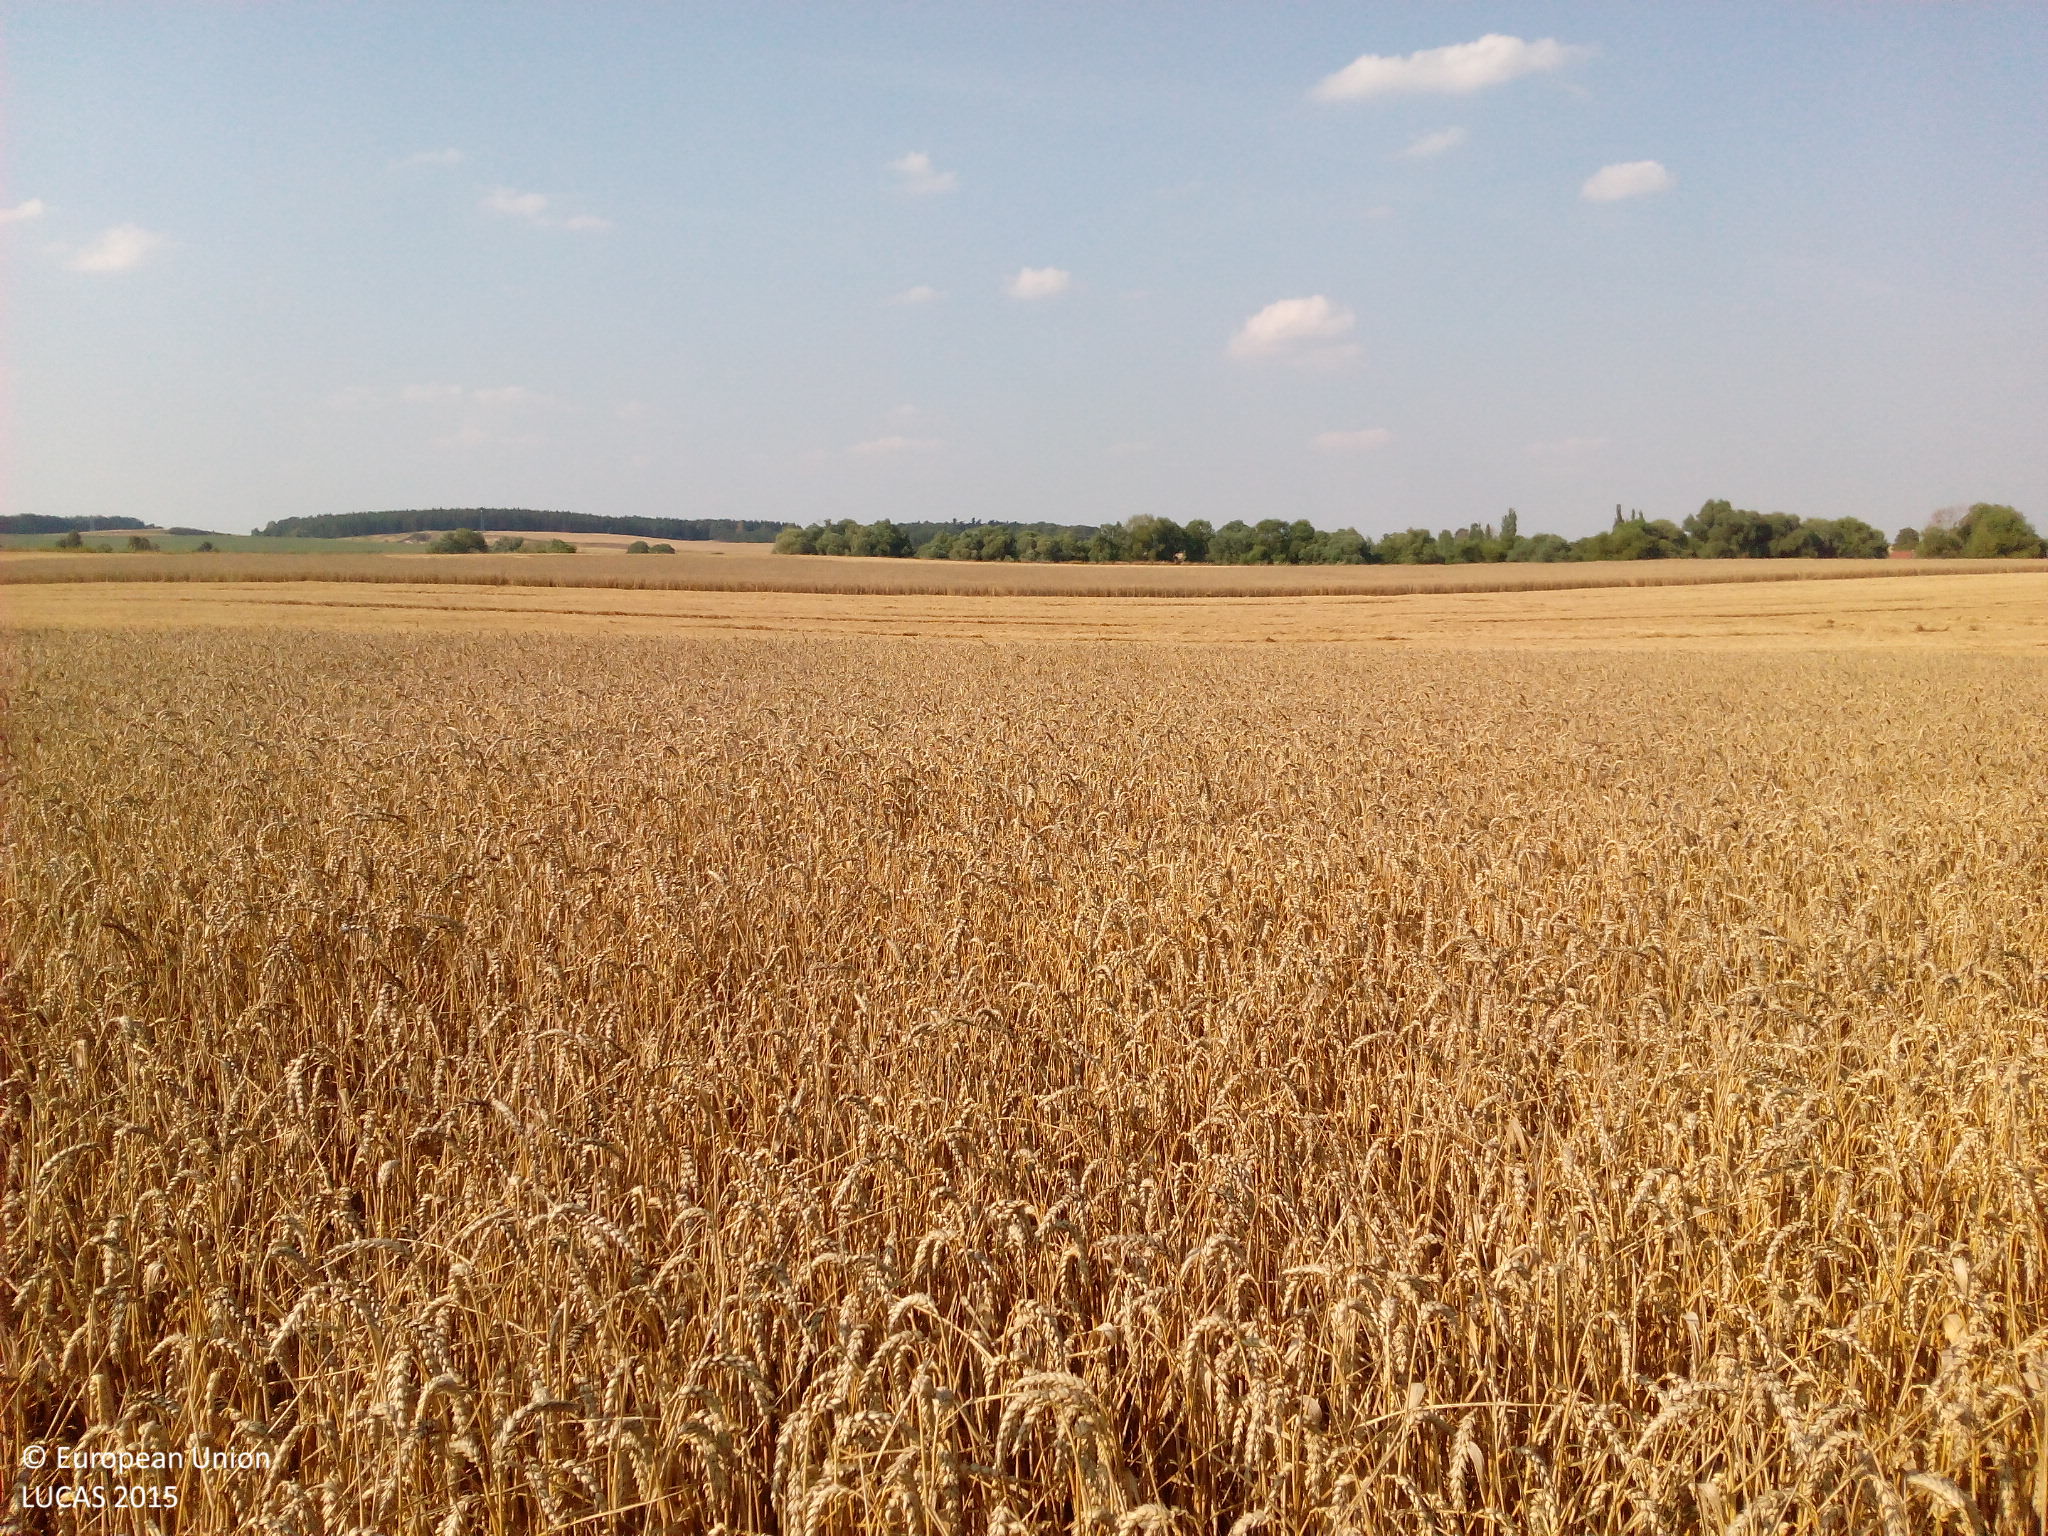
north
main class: Cropland
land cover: Common wheat
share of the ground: > 75 %
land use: Agriculture (excluding fallow land and kitchen gardens)
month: August
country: DE
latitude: 53.0245
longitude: 14.1604
